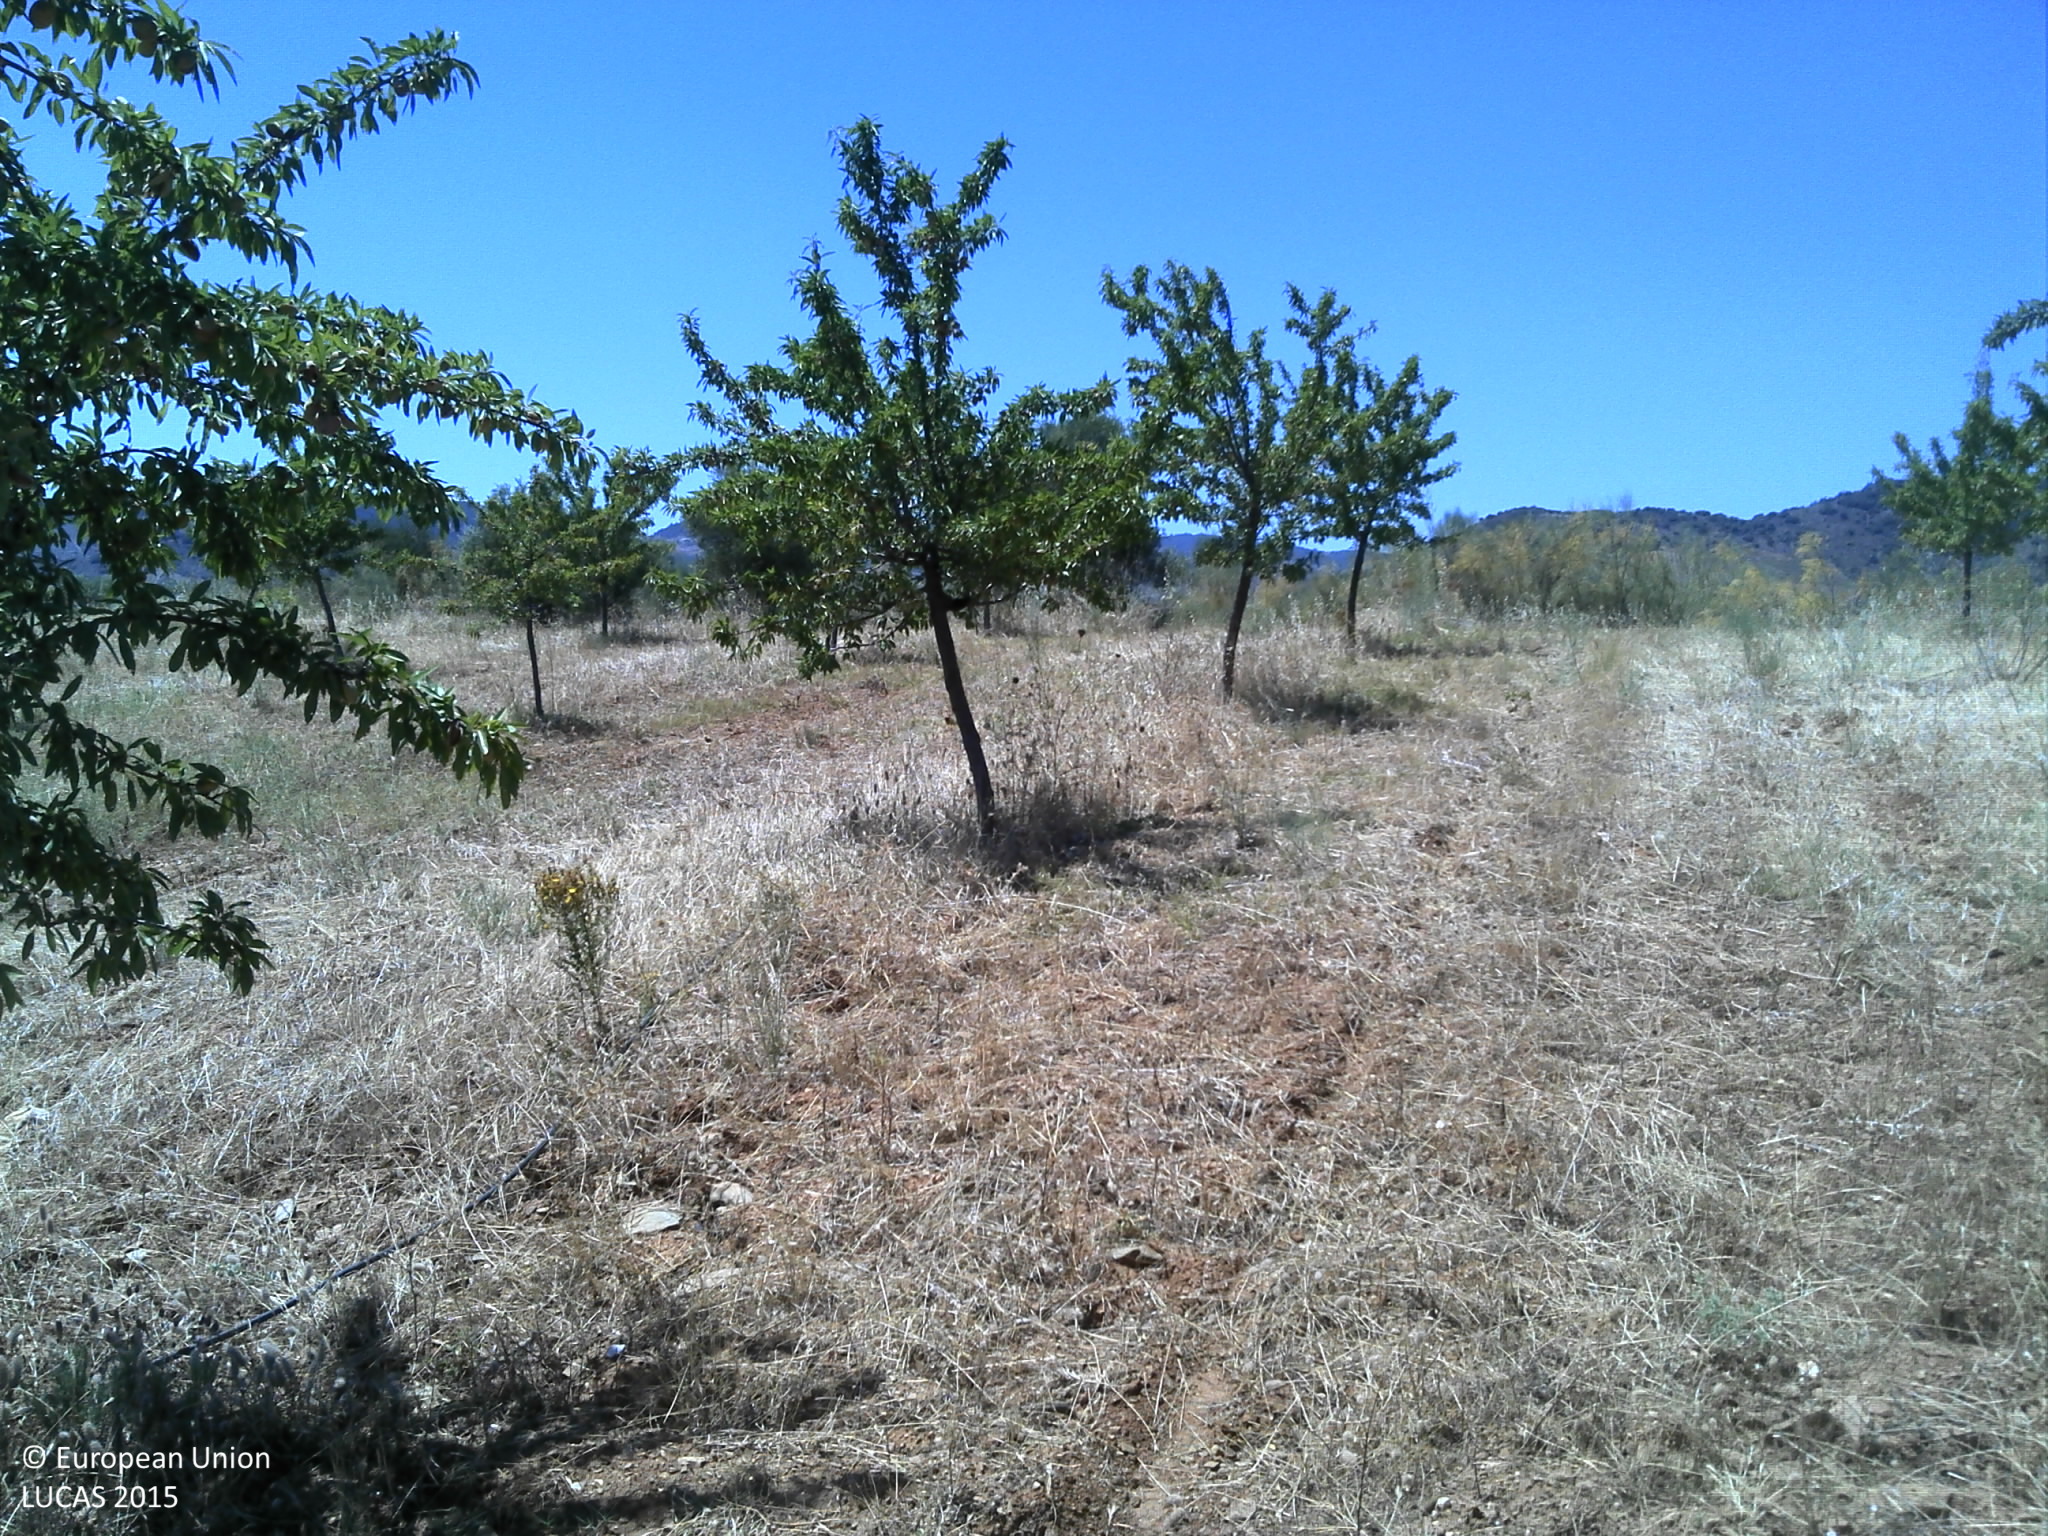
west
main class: Cropland
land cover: Nuts trees
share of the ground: < 10 %
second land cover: Grassland without tree/shrub cover
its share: > 75 %
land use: Agriculture (excluding fallow land and kitchen gardens)
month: July
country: PT
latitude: 41.3220
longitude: -7.0660
